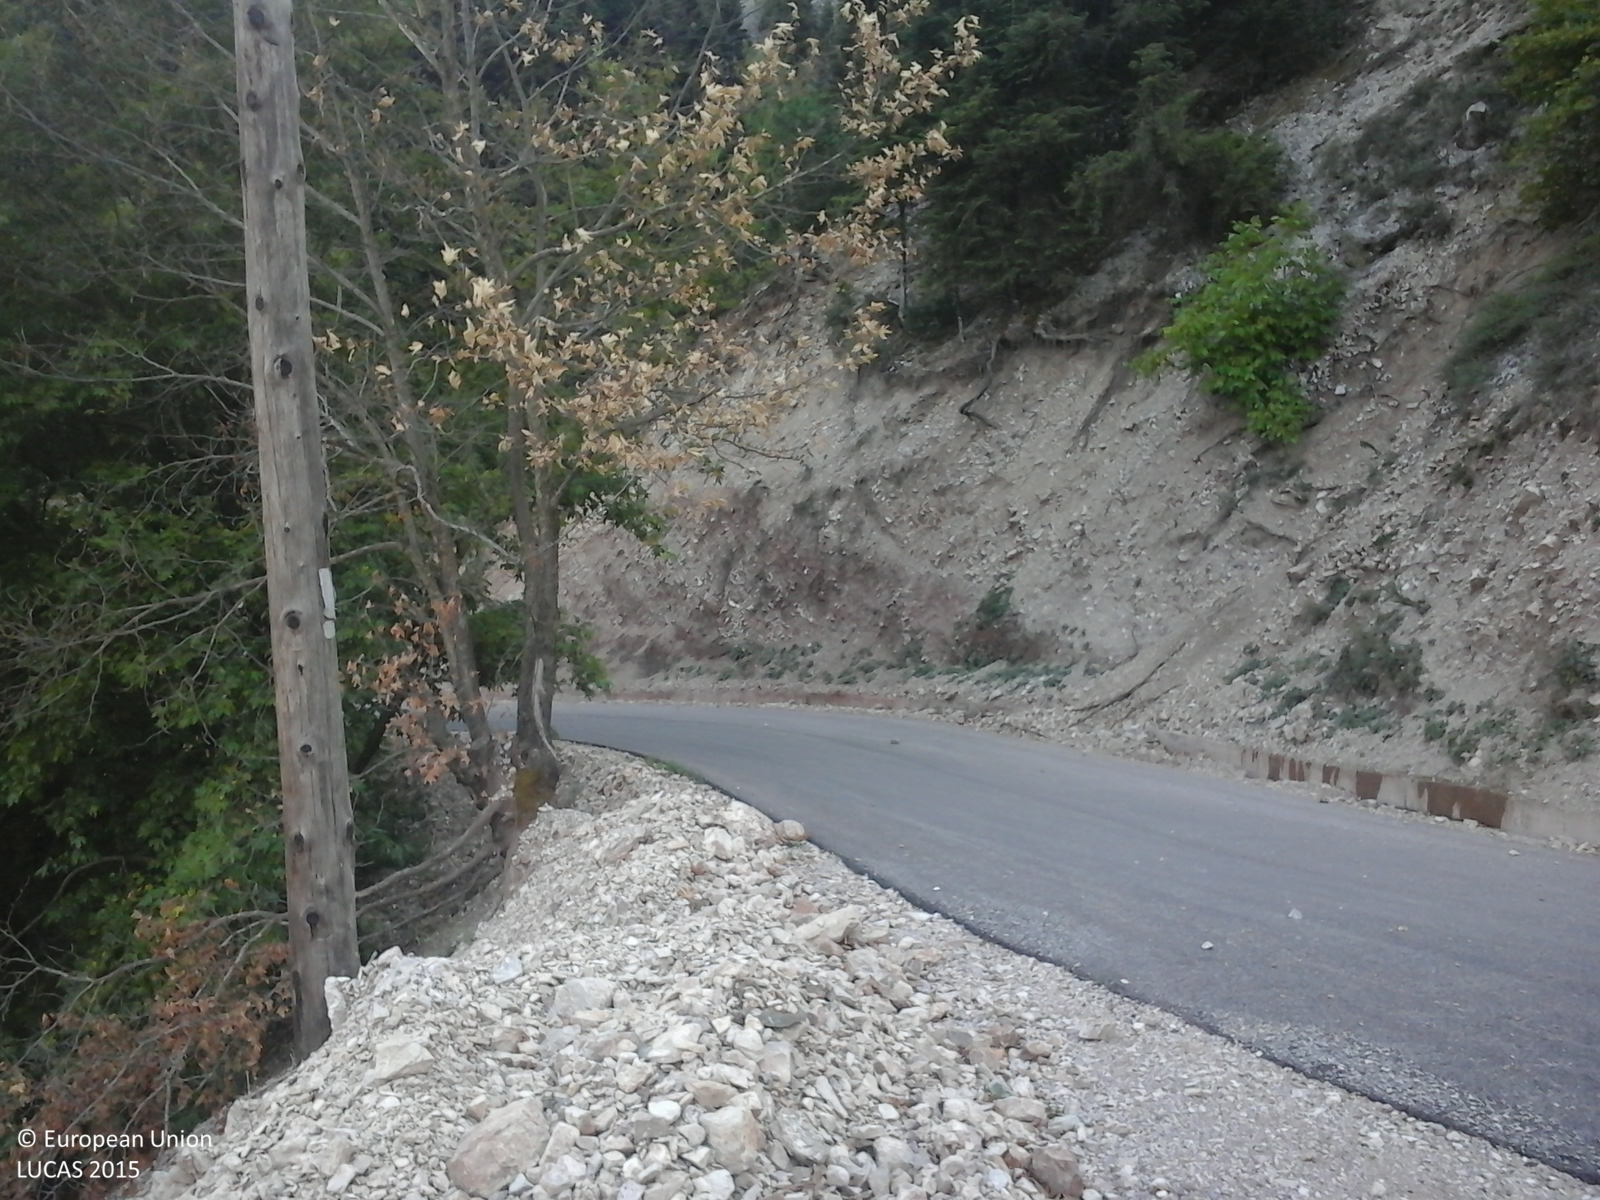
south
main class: Woodland
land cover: Spruce dominated coniferous woodland
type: coniferous forest of the mediterranean region
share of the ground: > 75 %
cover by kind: coniferous forest trees 75 %, unconsolidated bare surface 25 %
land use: Semi-natural and natural areas not in use
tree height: > 5 m
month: August
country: GR
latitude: 38.7428
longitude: 21.6970
